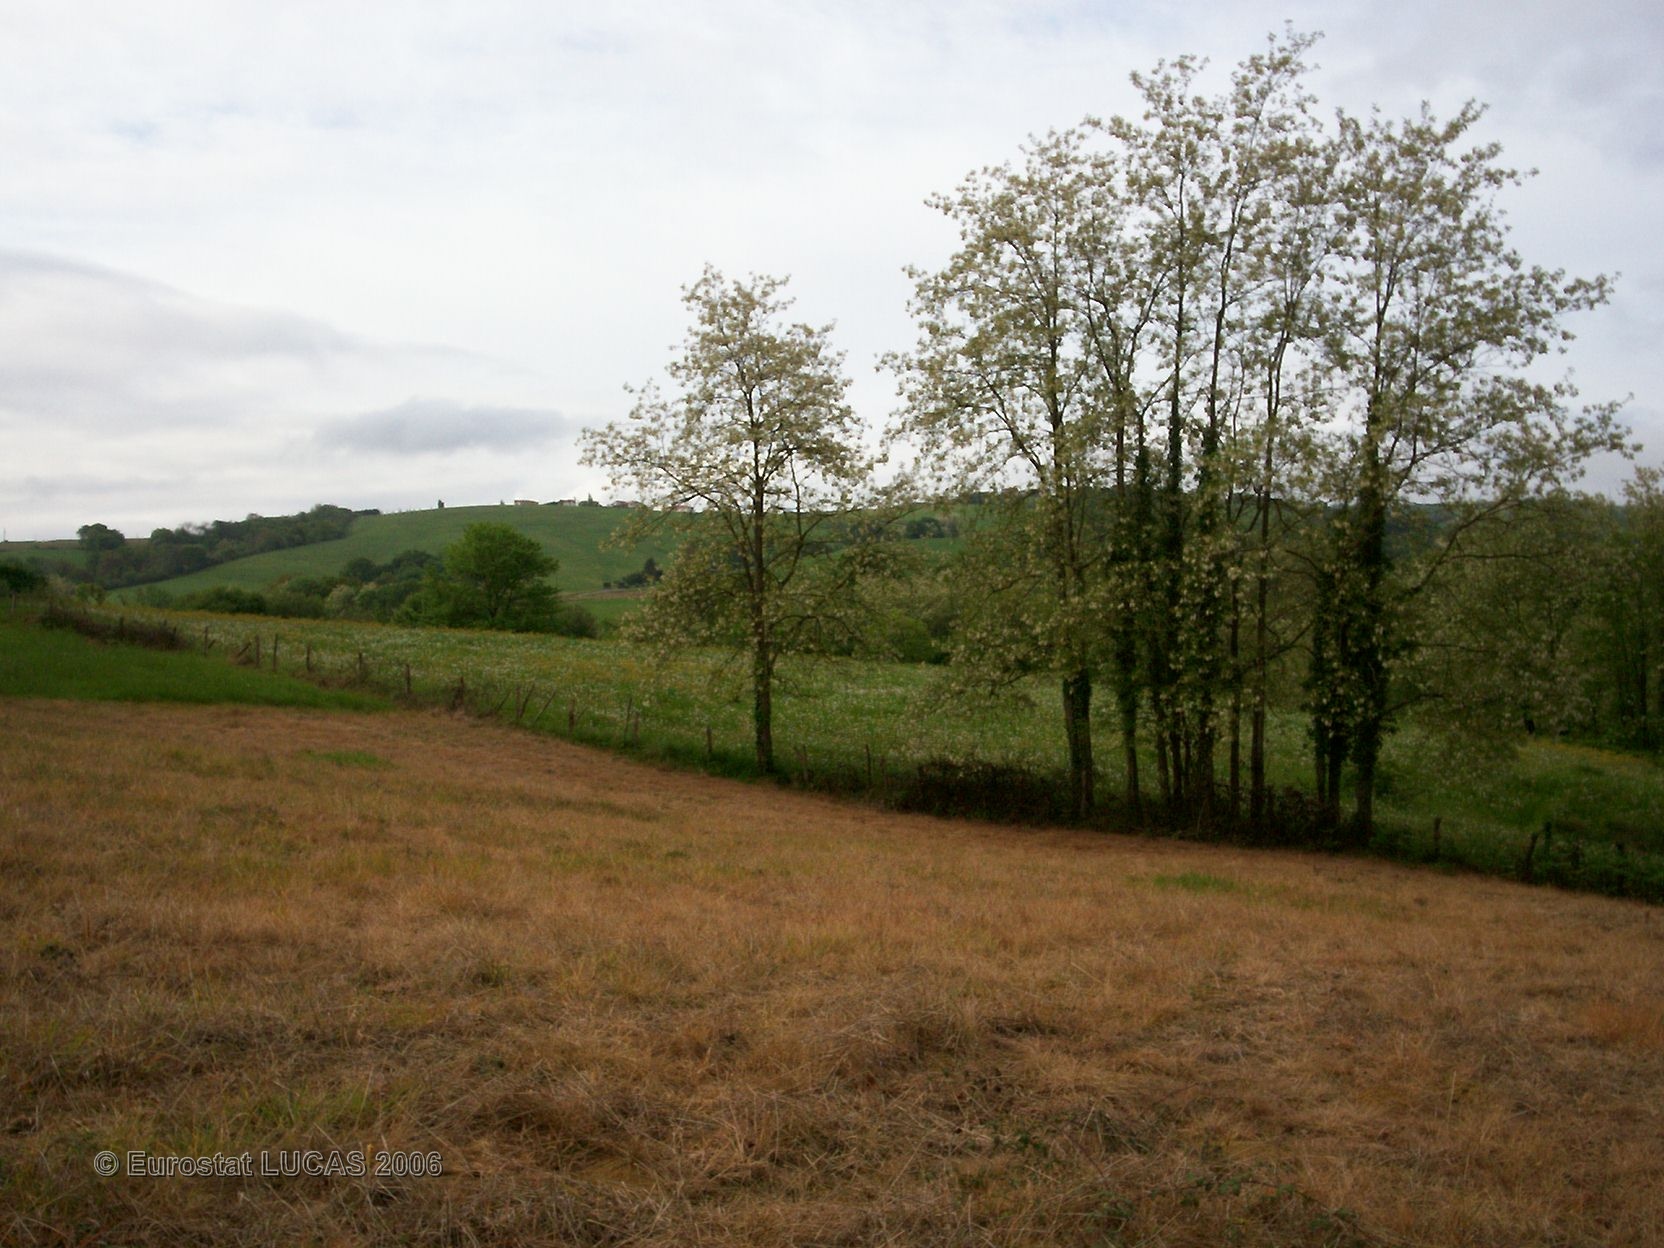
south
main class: Grassland
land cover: Grassland without tree/shrub cover
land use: Agriculture (excluding fallow land and kitchen gardens)
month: April
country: FR
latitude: 43.4528
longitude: -1.3489
